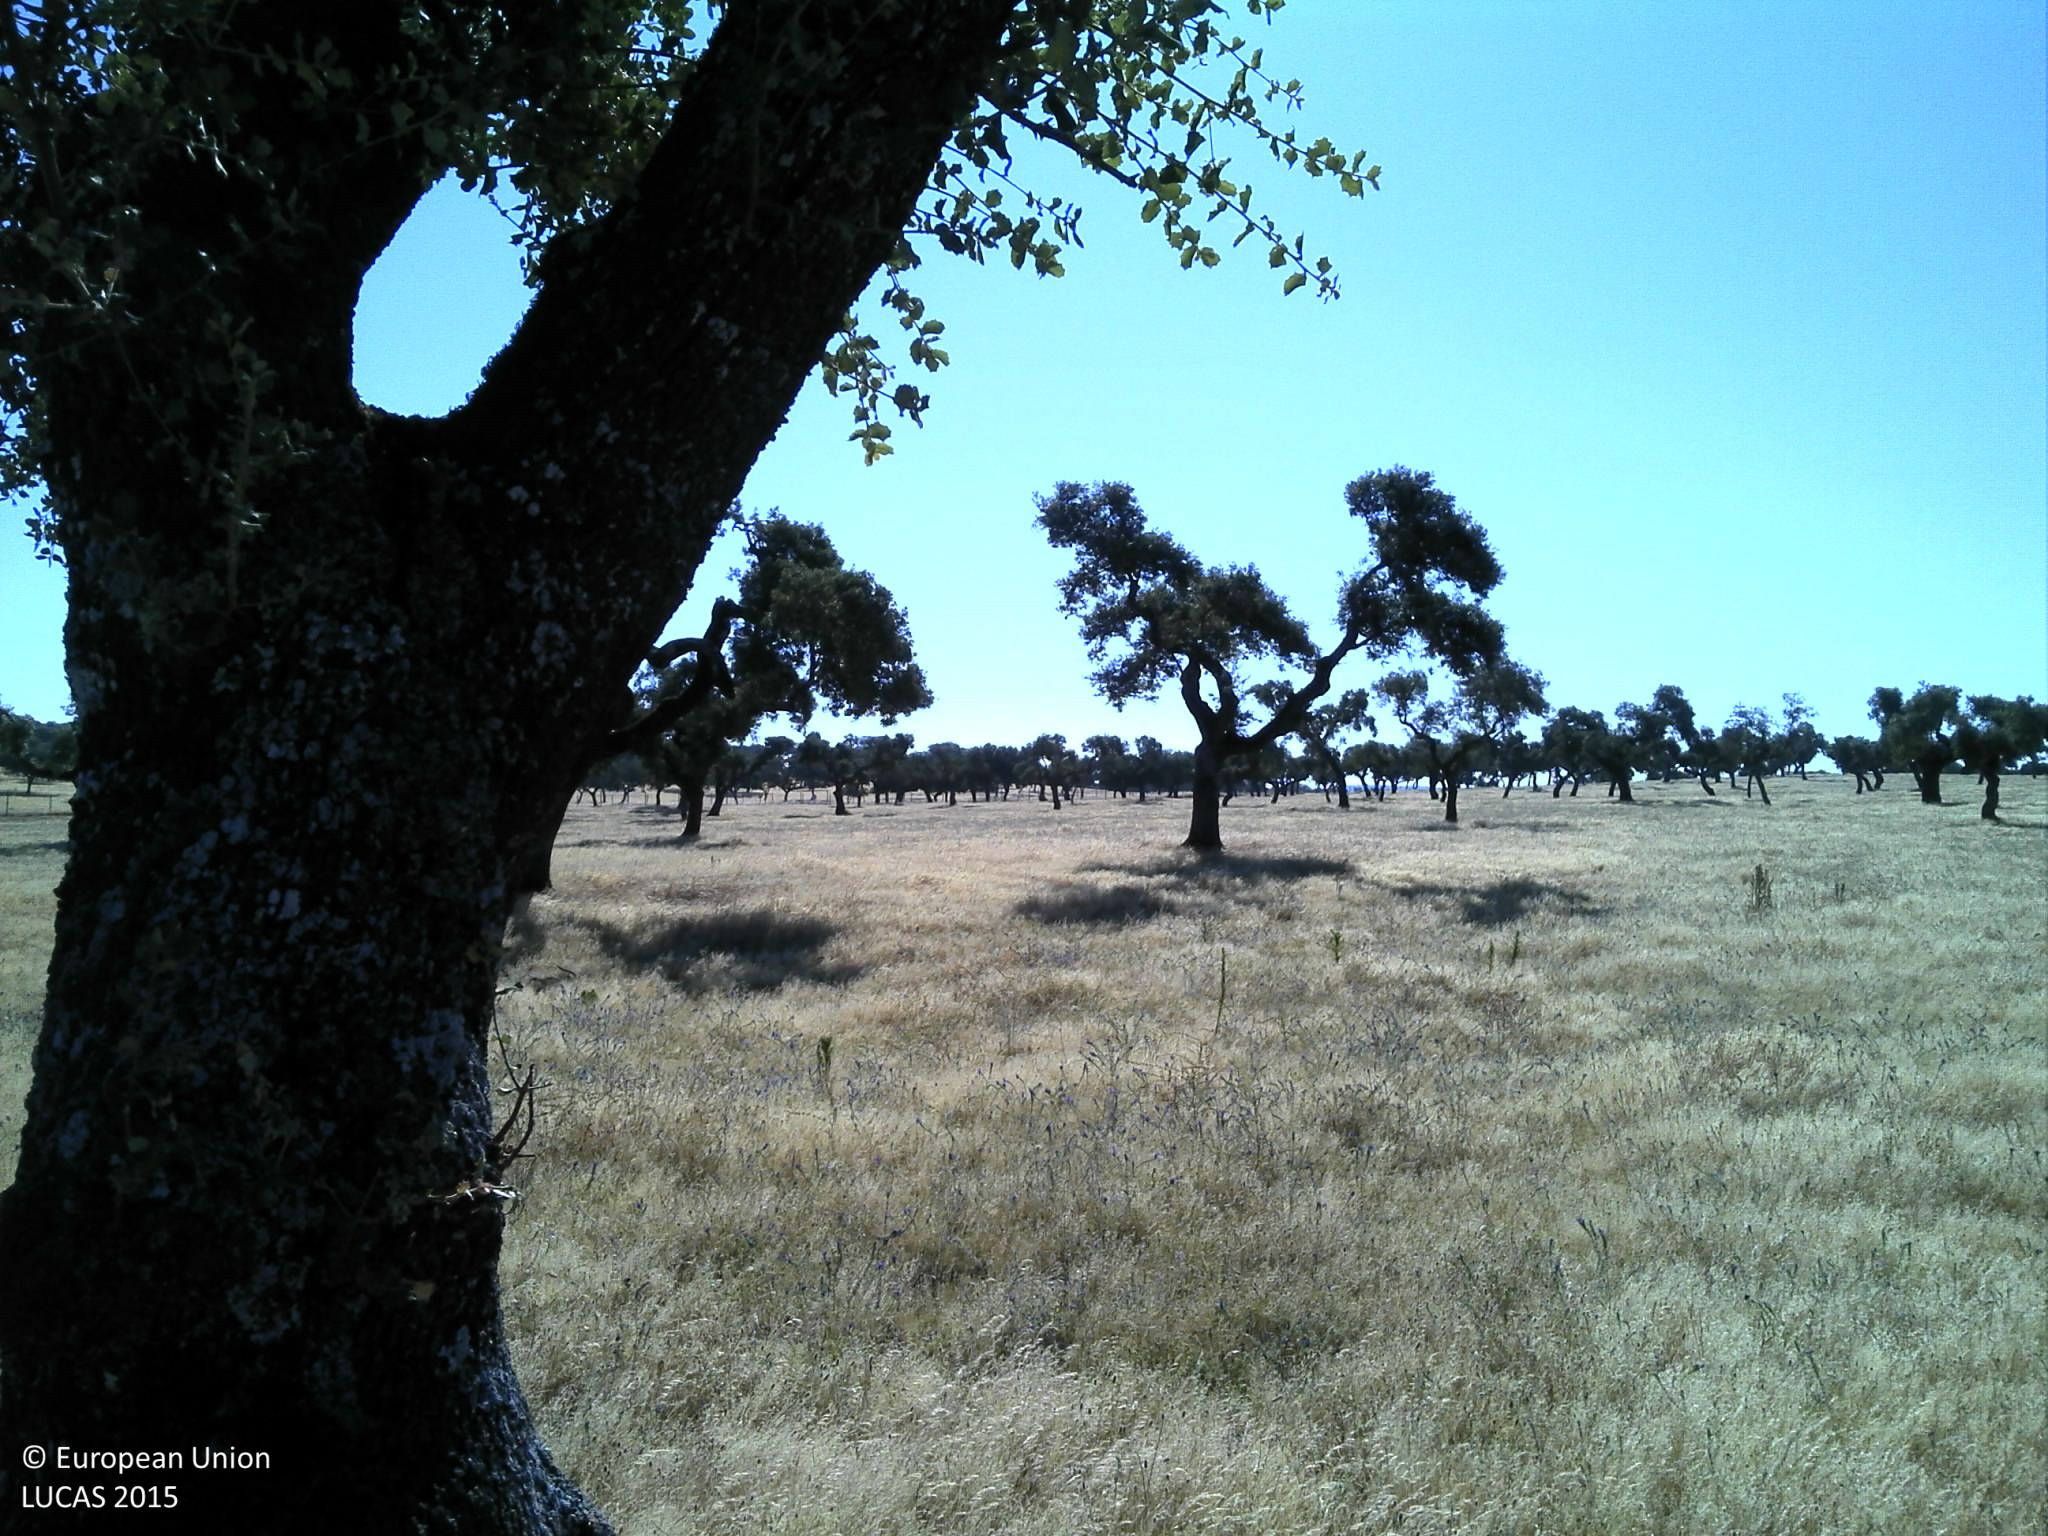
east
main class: Woodland
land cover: Broadleaved woodland
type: broadleaved evergreen forest
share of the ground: 25 - 50 %
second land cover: Grassland without tree/shrub cover
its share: 50 - 75 %
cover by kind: herbaceous plants 50 %, broadleaved forest trees 40 %, unconsolidated bare surface 10 %
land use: Forestry
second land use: Agriculture (excluding fallow land and kitchen gardens)
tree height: > 5 m
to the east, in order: Broadleaved woodland; Grassland without tree/shrub cover; Broadleaved woodland
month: June
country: PT
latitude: 38.7704
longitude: -8.2012
